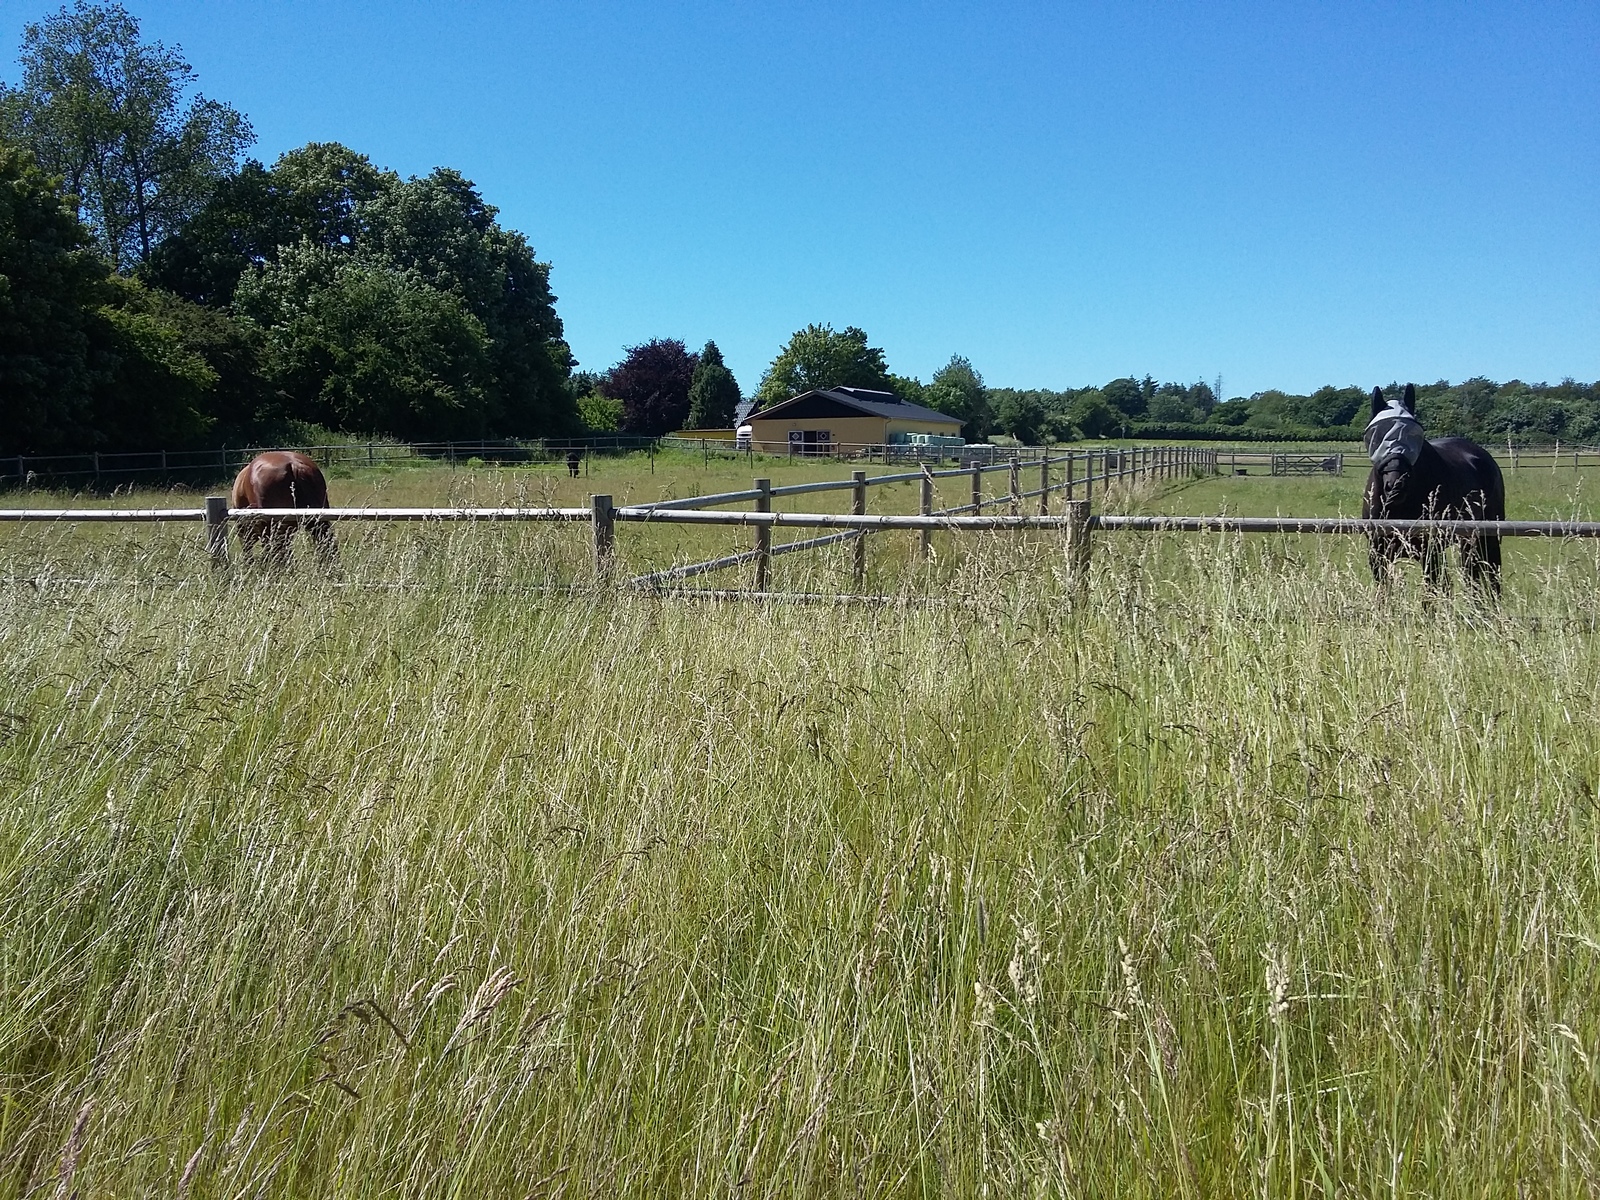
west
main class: Grassland
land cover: Grassland without tree/shrub cover
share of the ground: > 75 %
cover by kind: herbaceous plants 100 %
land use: Agriculture (excluding fallow land and kitchen gardens)
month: July
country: DK
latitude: 55.0930
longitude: 12.0199
